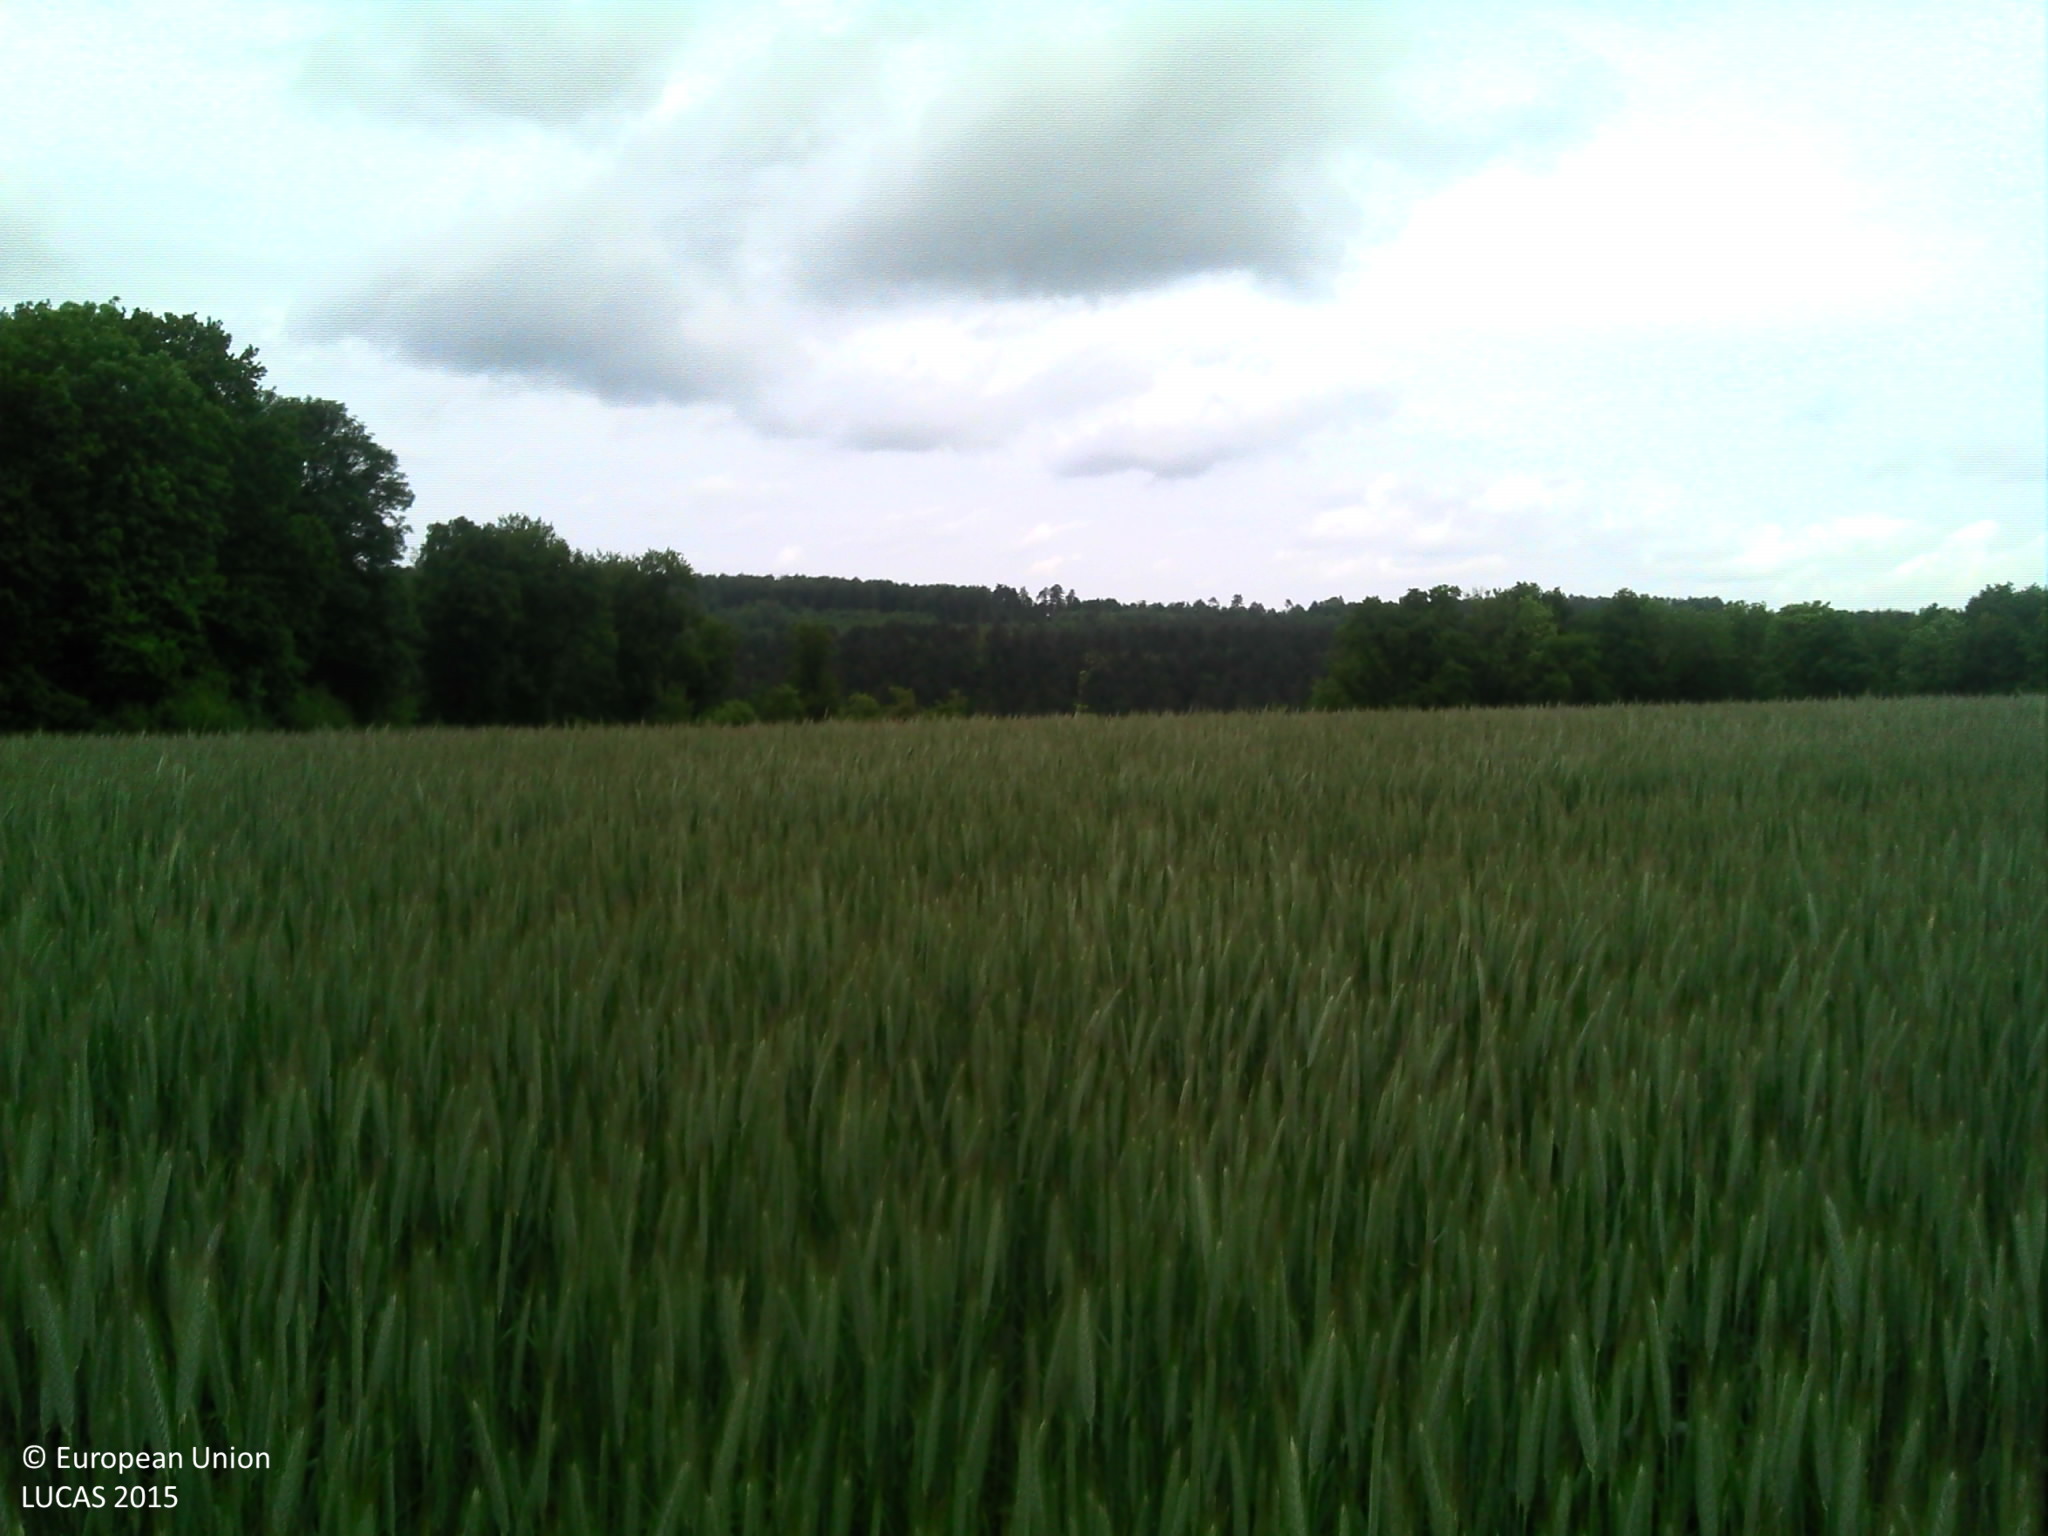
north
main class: Cropland
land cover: Triticale
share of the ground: > 75 %
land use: Agriculture (excluding fallow land and kitchen gardens)
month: May
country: BE
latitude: 50.1575
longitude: 5.2528
